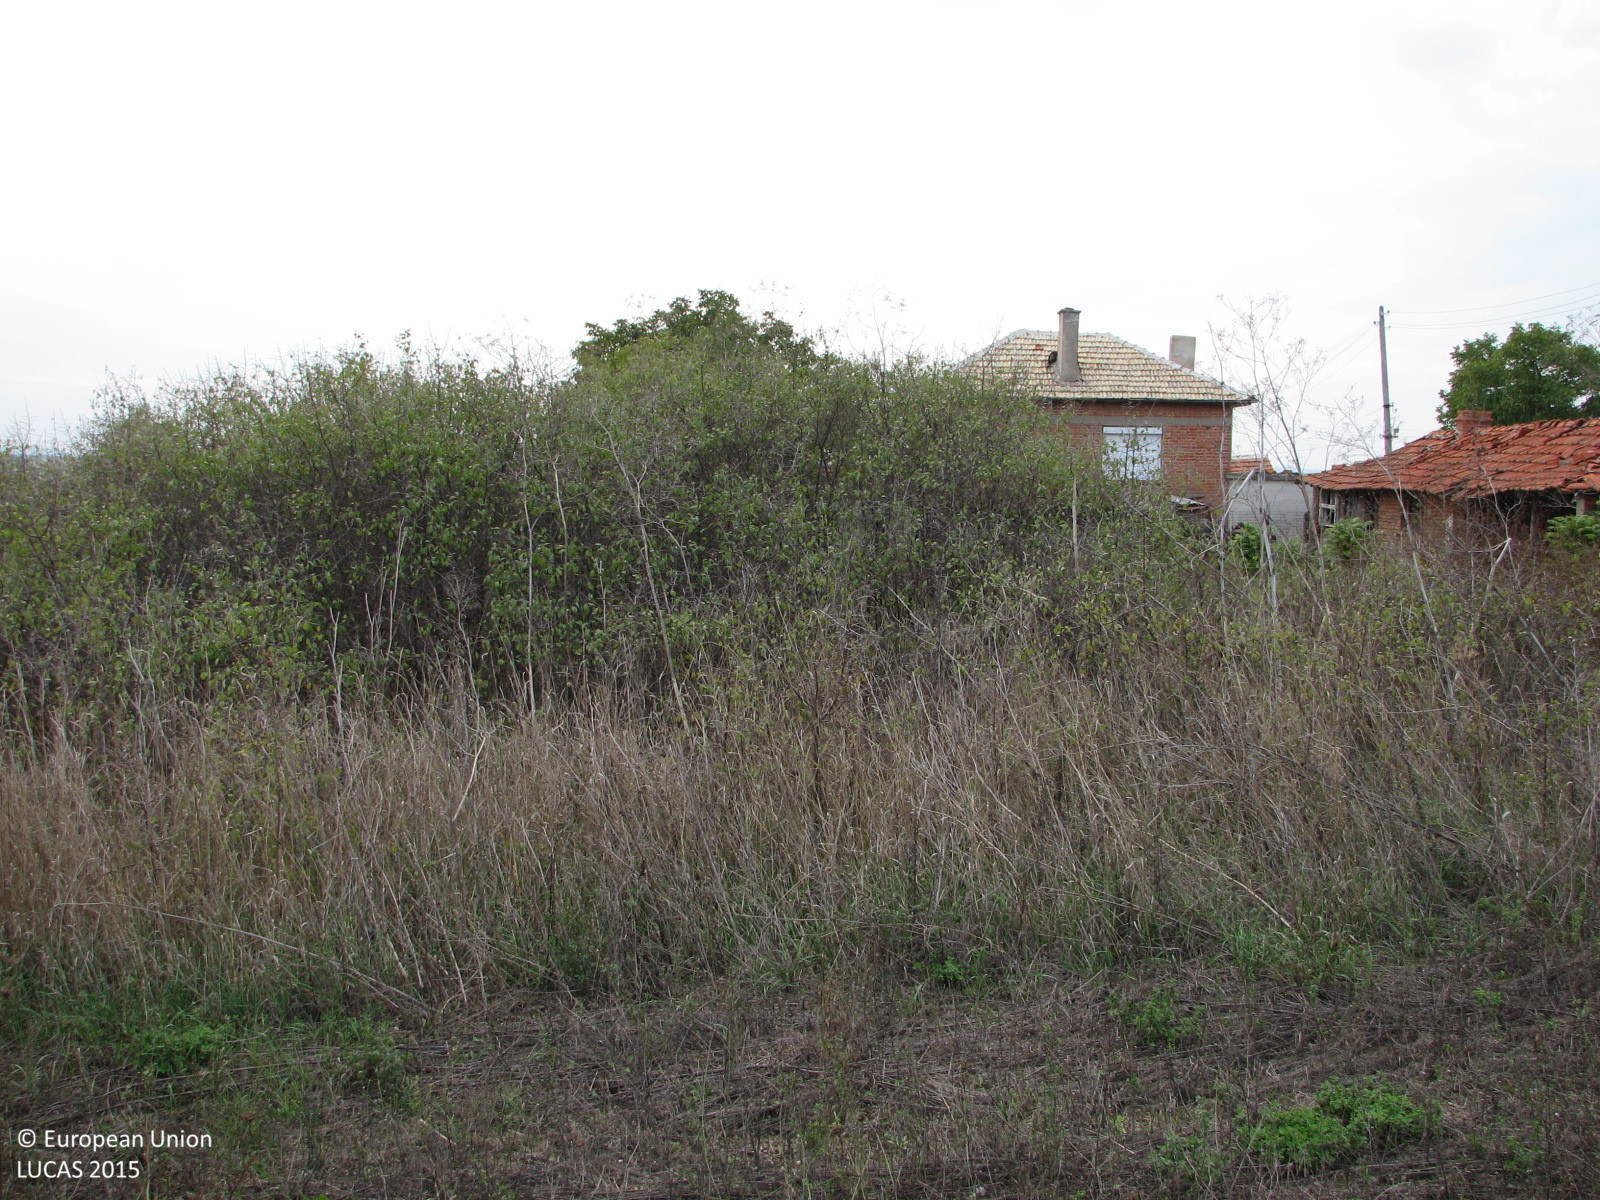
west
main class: Cropland
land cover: Lucerne
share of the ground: 25 - 50 %
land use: Agriculture (excluding fallow land and kitchen gardens)
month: October
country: BG
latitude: 42.2797
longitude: 26.5207
